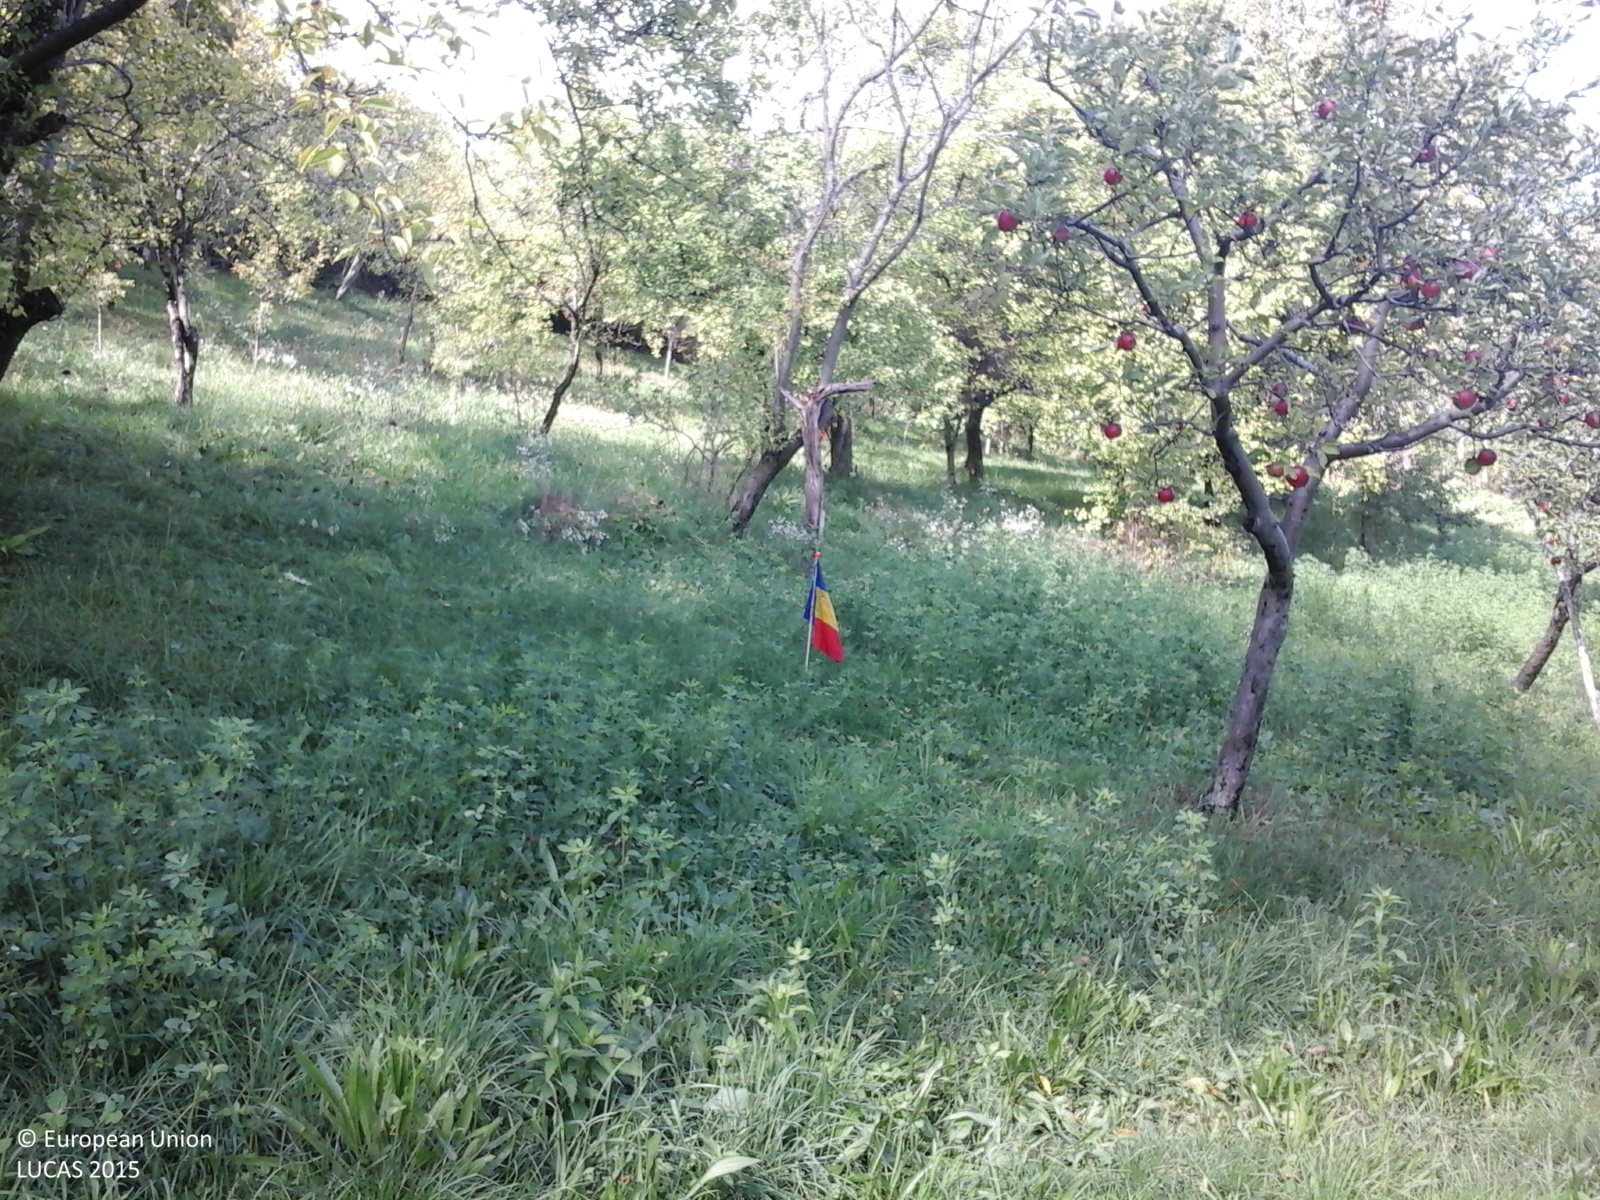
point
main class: Cropland
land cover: Apple fruit
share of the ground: 25 - 50 %
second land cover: Grassland without tree/shrub cover
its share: > 75 %
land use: Agriculture (excluding fallow land and kitchen gardens)
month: September
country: RO
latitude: 45.1888
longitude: 24.5234
